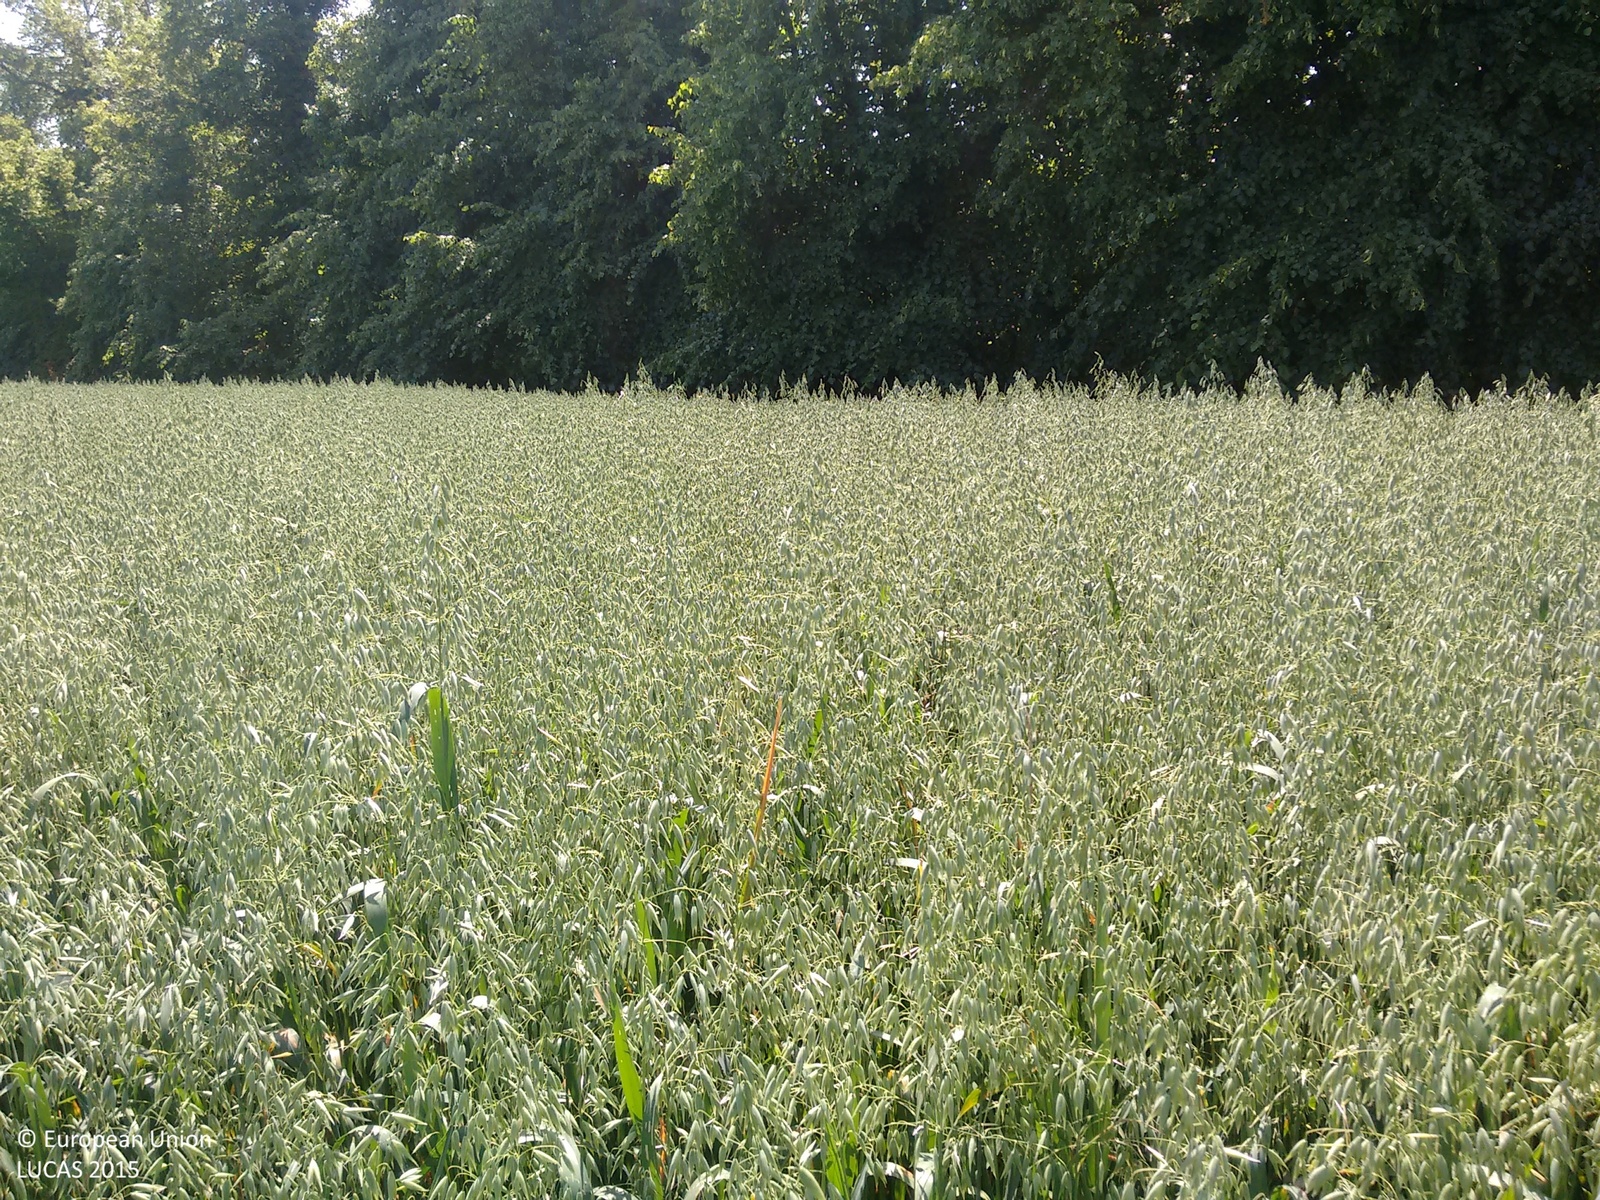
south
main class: Cropland
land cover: Oats
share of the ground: > 75 %
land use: Agriculture (excluding fallow land and kitchen gardens)
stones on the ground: 10 - 25 %
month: July
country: GB
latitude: 51.0713
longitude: -0.3551
